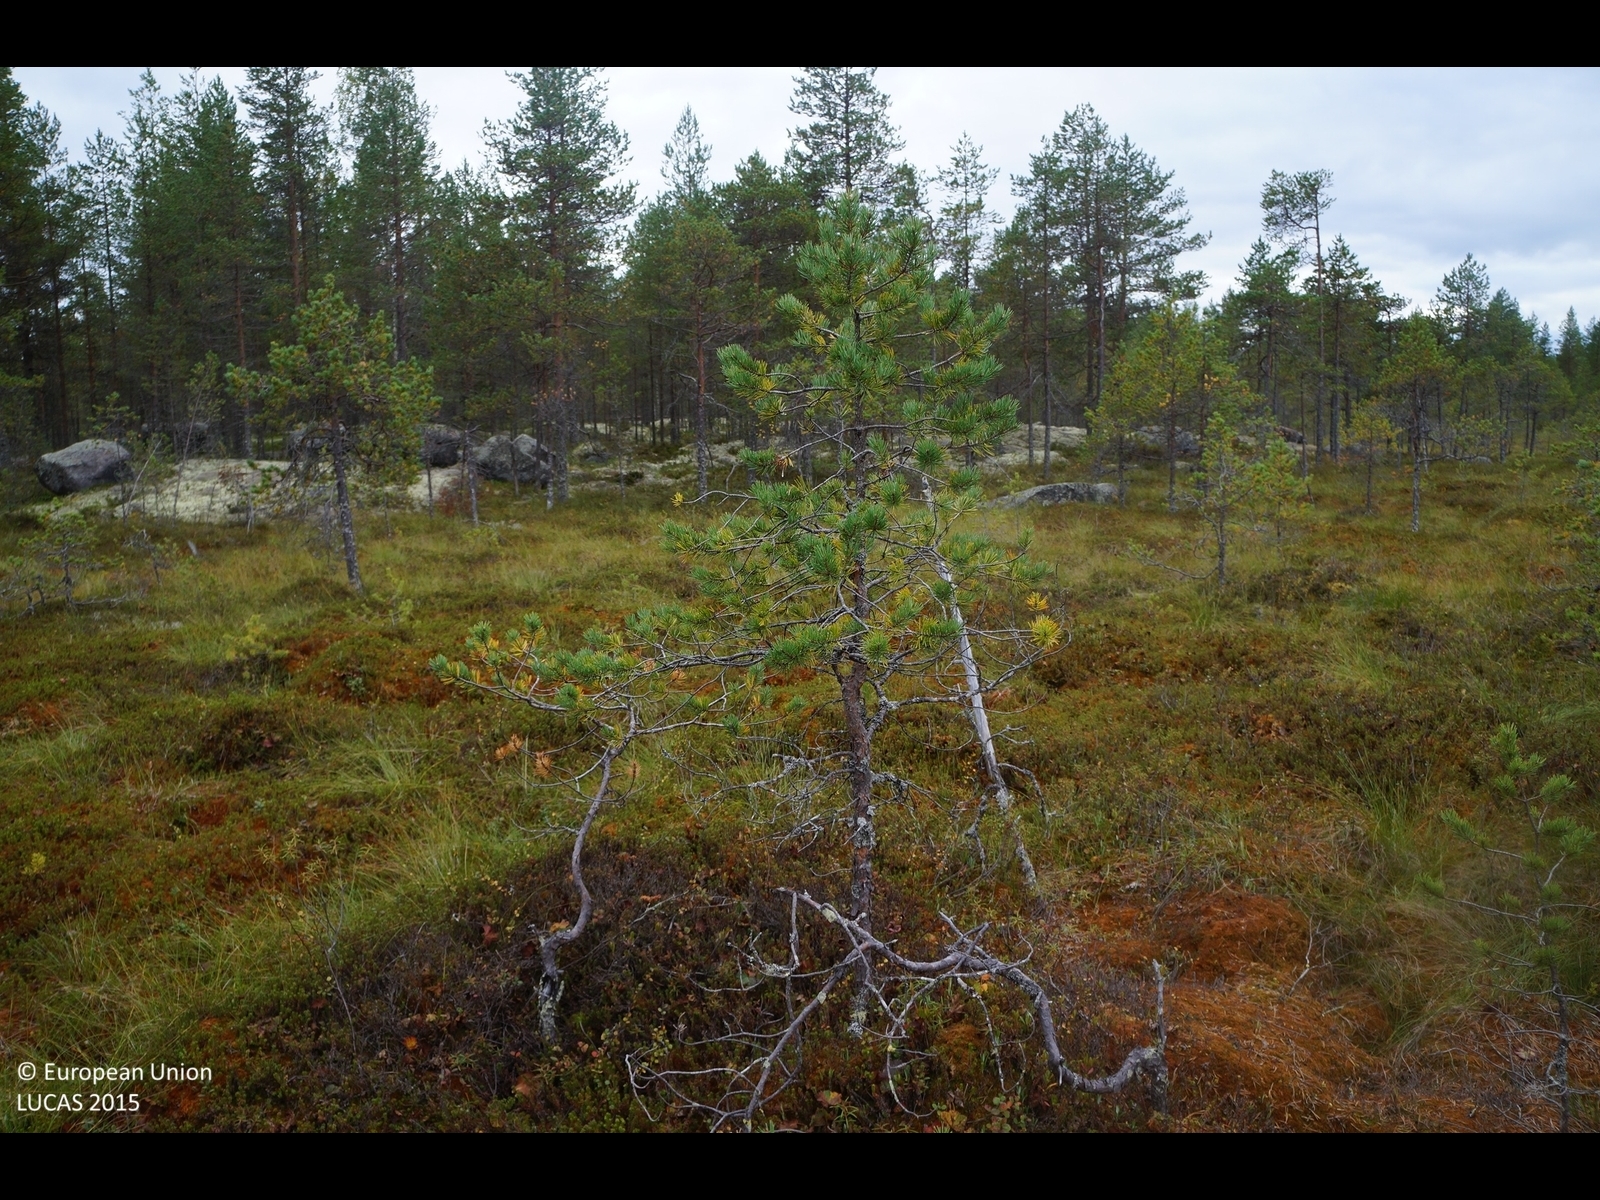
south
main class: Woodland
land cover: Pine dominated coniferous woodland
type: boreal forest
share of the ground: 25 - 50 %
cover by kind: shrubs 30 %, lichens and mosses 30 %, coniferous forest trees 25 %, herbaceous plants 15 %
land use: Semi-natural and natural areas not in use
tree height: < 5 m
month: September
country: FI
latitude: 64.0200
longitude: 24.1237
